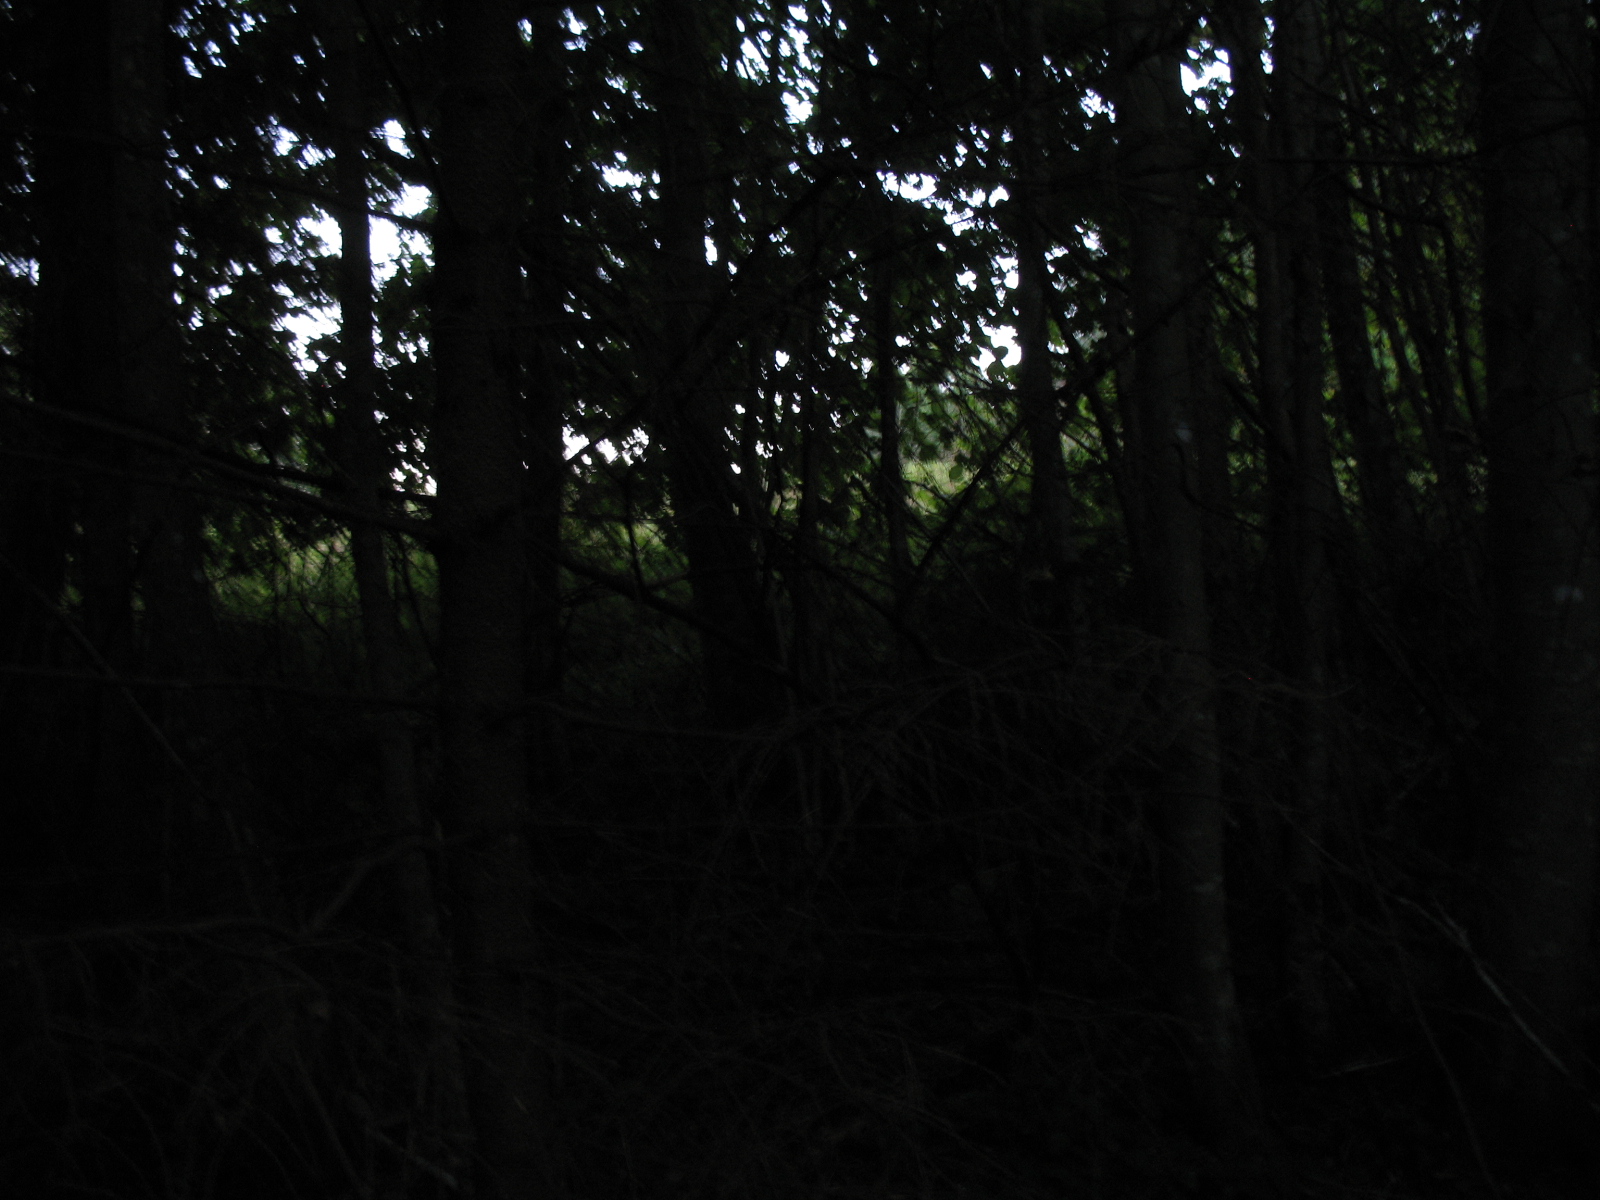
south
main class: Woodland
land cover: Broadleaved woodland
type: non-riverine alder, birch or aspen forest
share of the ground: > 75 %
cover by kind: broadleaved forest trees 90 %, unconsolidated bare surface 5 %
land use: Forestry
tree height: > 5 m
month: August
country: LV
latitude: 56.4702
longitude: 25.6257
